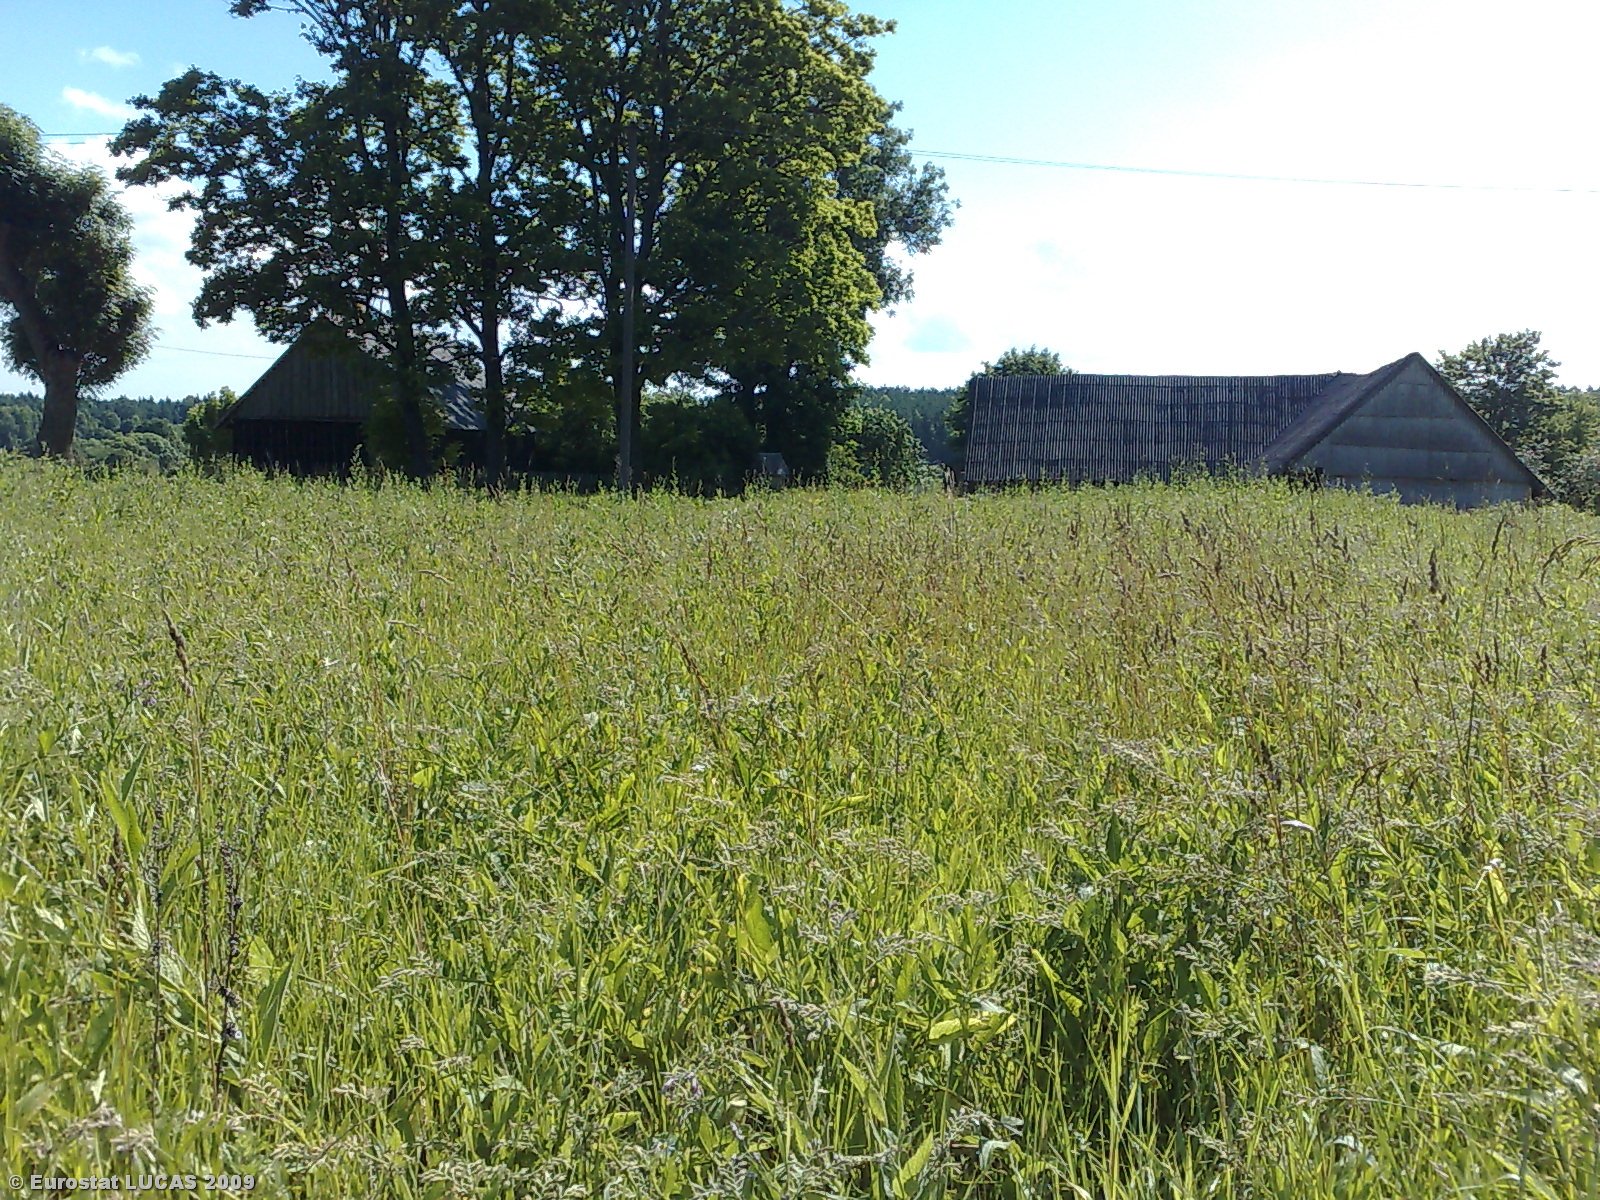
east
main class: Grassland
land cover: Grassland without tree/shrub cover
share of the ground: > 75 %
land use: Agriculture (excluding fallow land and kitchen gardens)
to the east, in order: Grassland without tree/shrub cover; Electric lines; Grassland without tree/shrub cover; Paved roads, cycling and walking lanes; Grassland without tree/shrub cover; Artificial constructions in urban areas; Apple fruit; Grassland without tree/shrub cover; Spontaneously vegetated surfaces
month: July
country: LT
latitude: 55.9001
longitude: 22.8768
